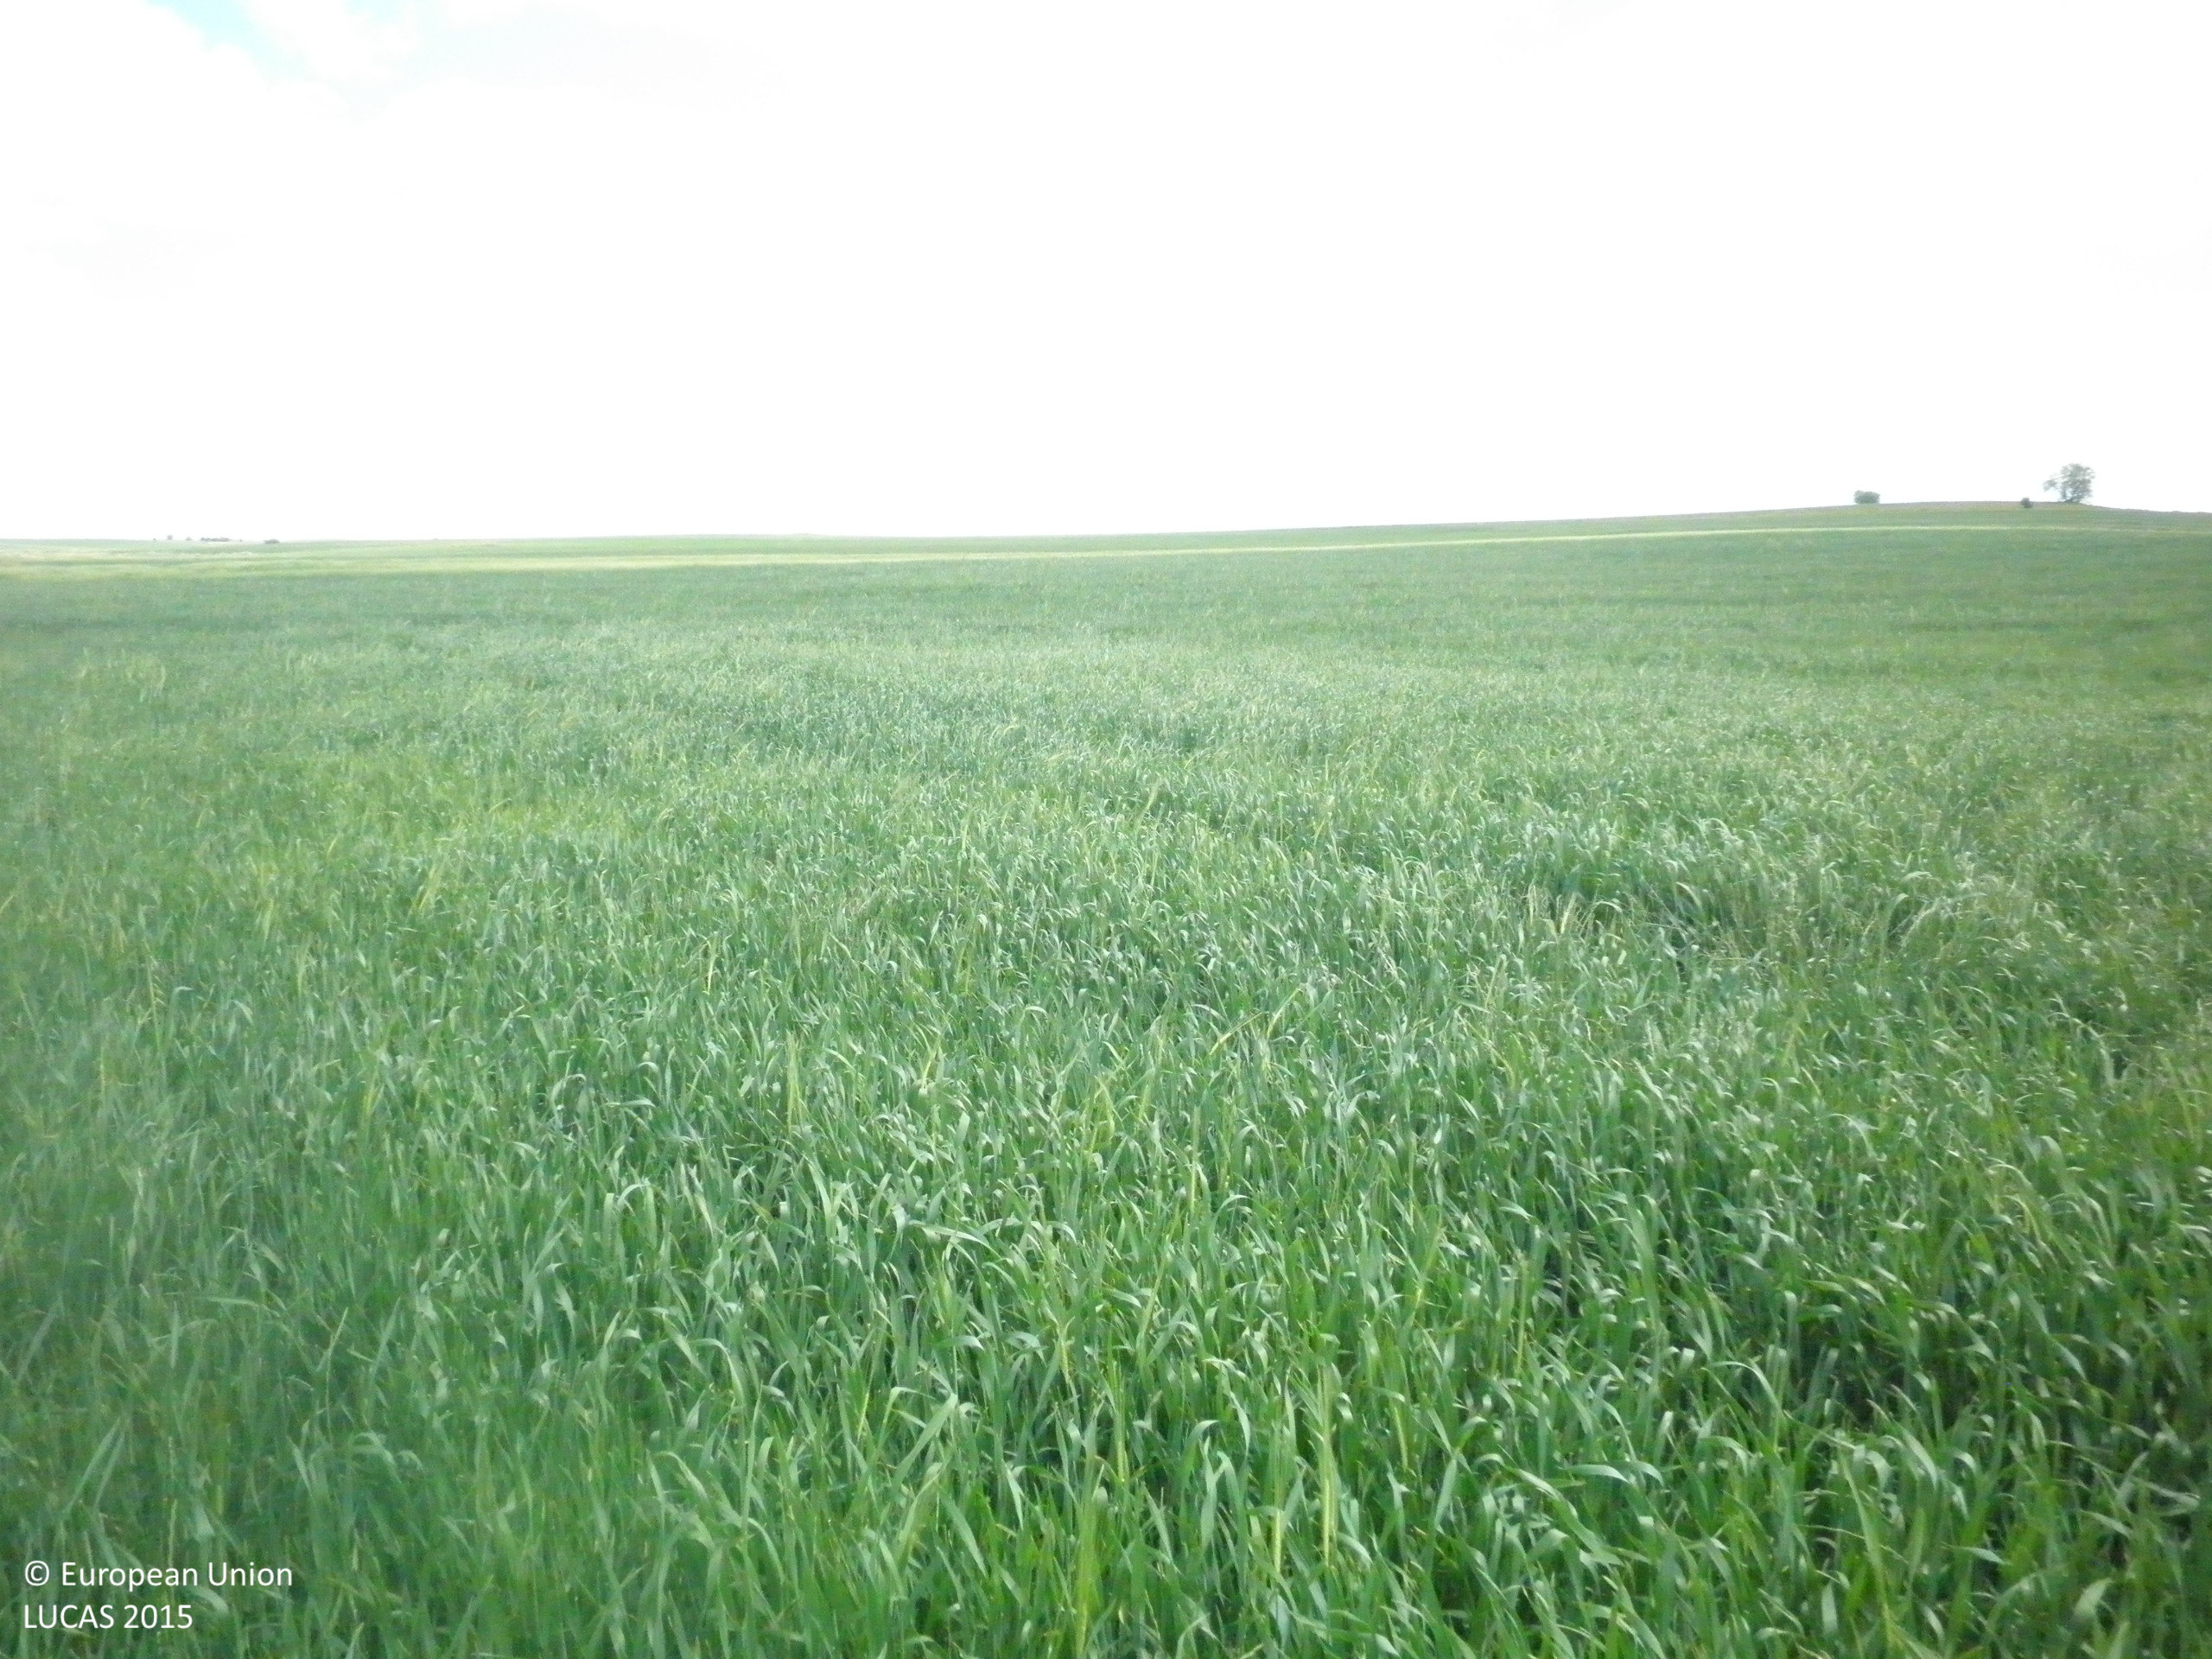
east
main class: Cropland
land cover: Barley
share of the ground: > 75 %
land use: Agriculture (excluding fallow land and kitchen gardens)
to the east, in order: Barley; Spontaneously vegetated surfaces
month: May
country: ES
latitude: 39.7159
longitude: -2.8146
